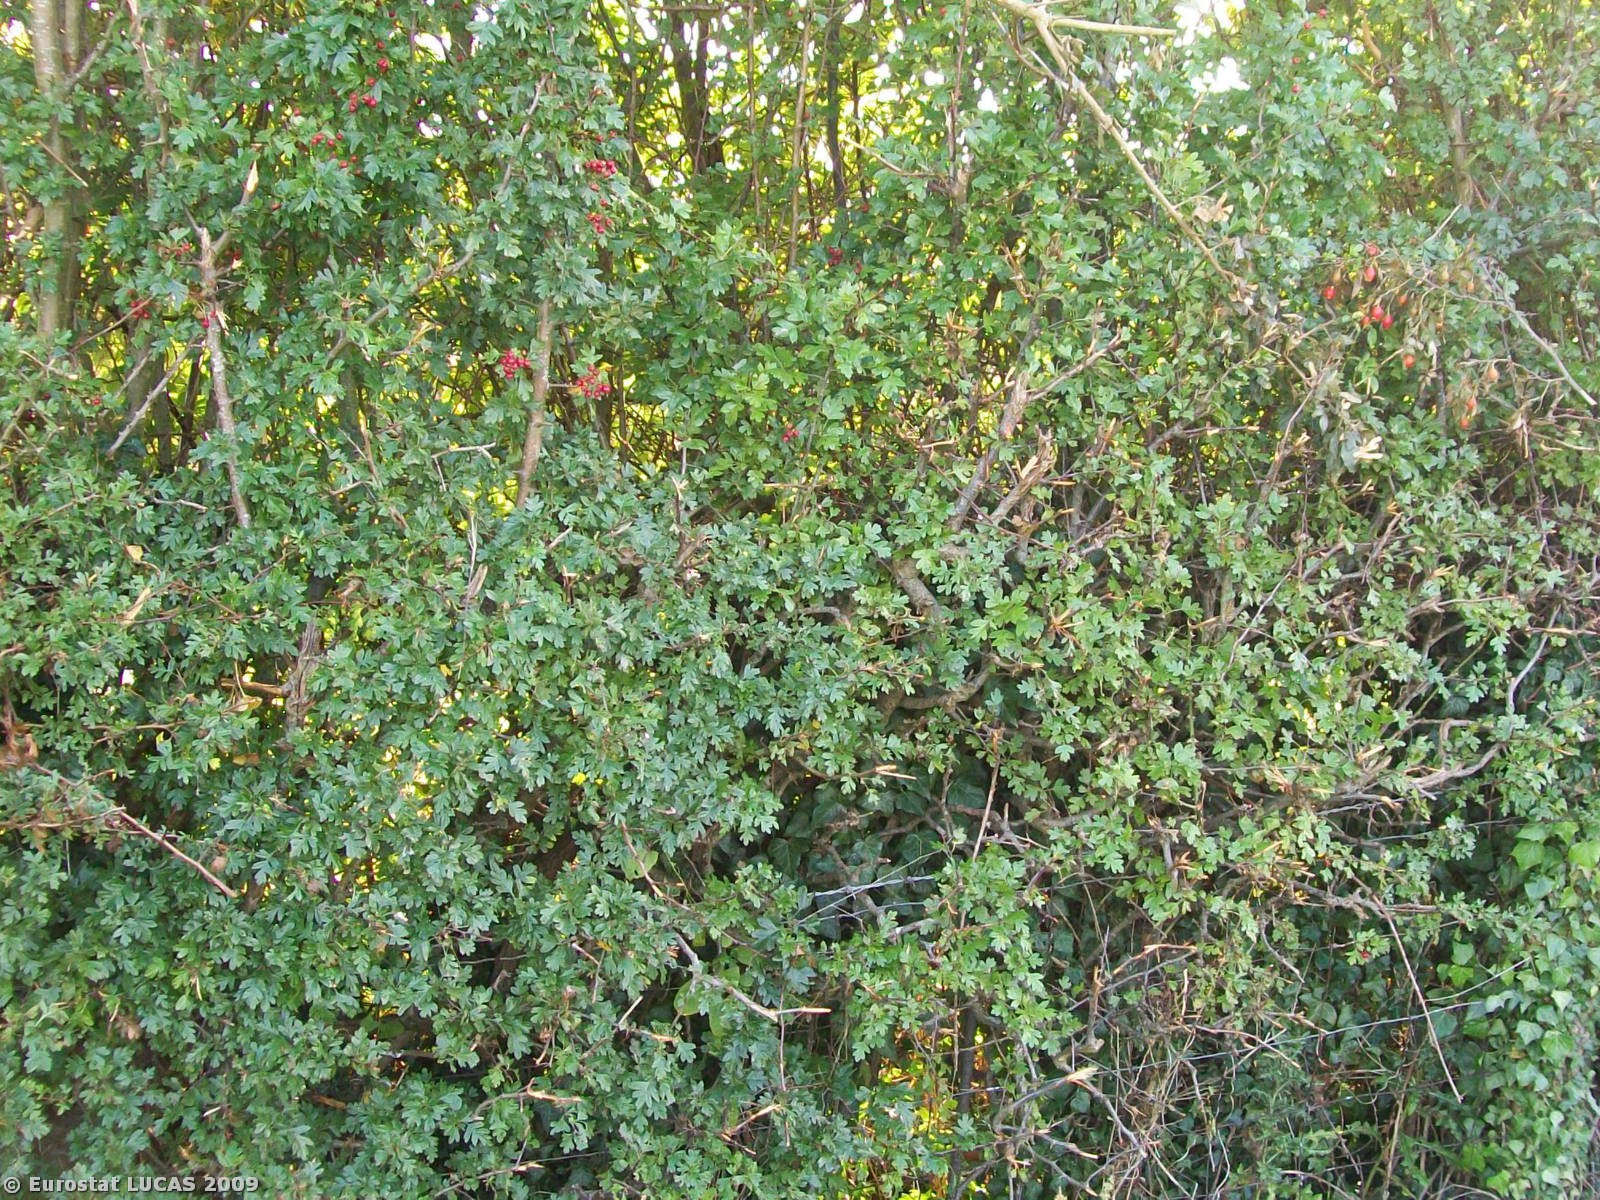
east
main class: Cropland
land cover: Maize
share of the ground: 25 - 50 %
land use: Agriculture (excluding fallow land and kitchen gardens)
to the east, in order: Maize; Grass margins; Managed hedges; Grass margins; Paved roads, cycling and walking lanes; Grass margins; Managed hedges; Grassland without tree/shrub cover; Apple fruit; Grassland without tree/shrub cover; Fences; Managed hedges; Grassland without tree/shrub cover
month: September
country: GB
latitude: 52.1146
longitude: -2.4937
